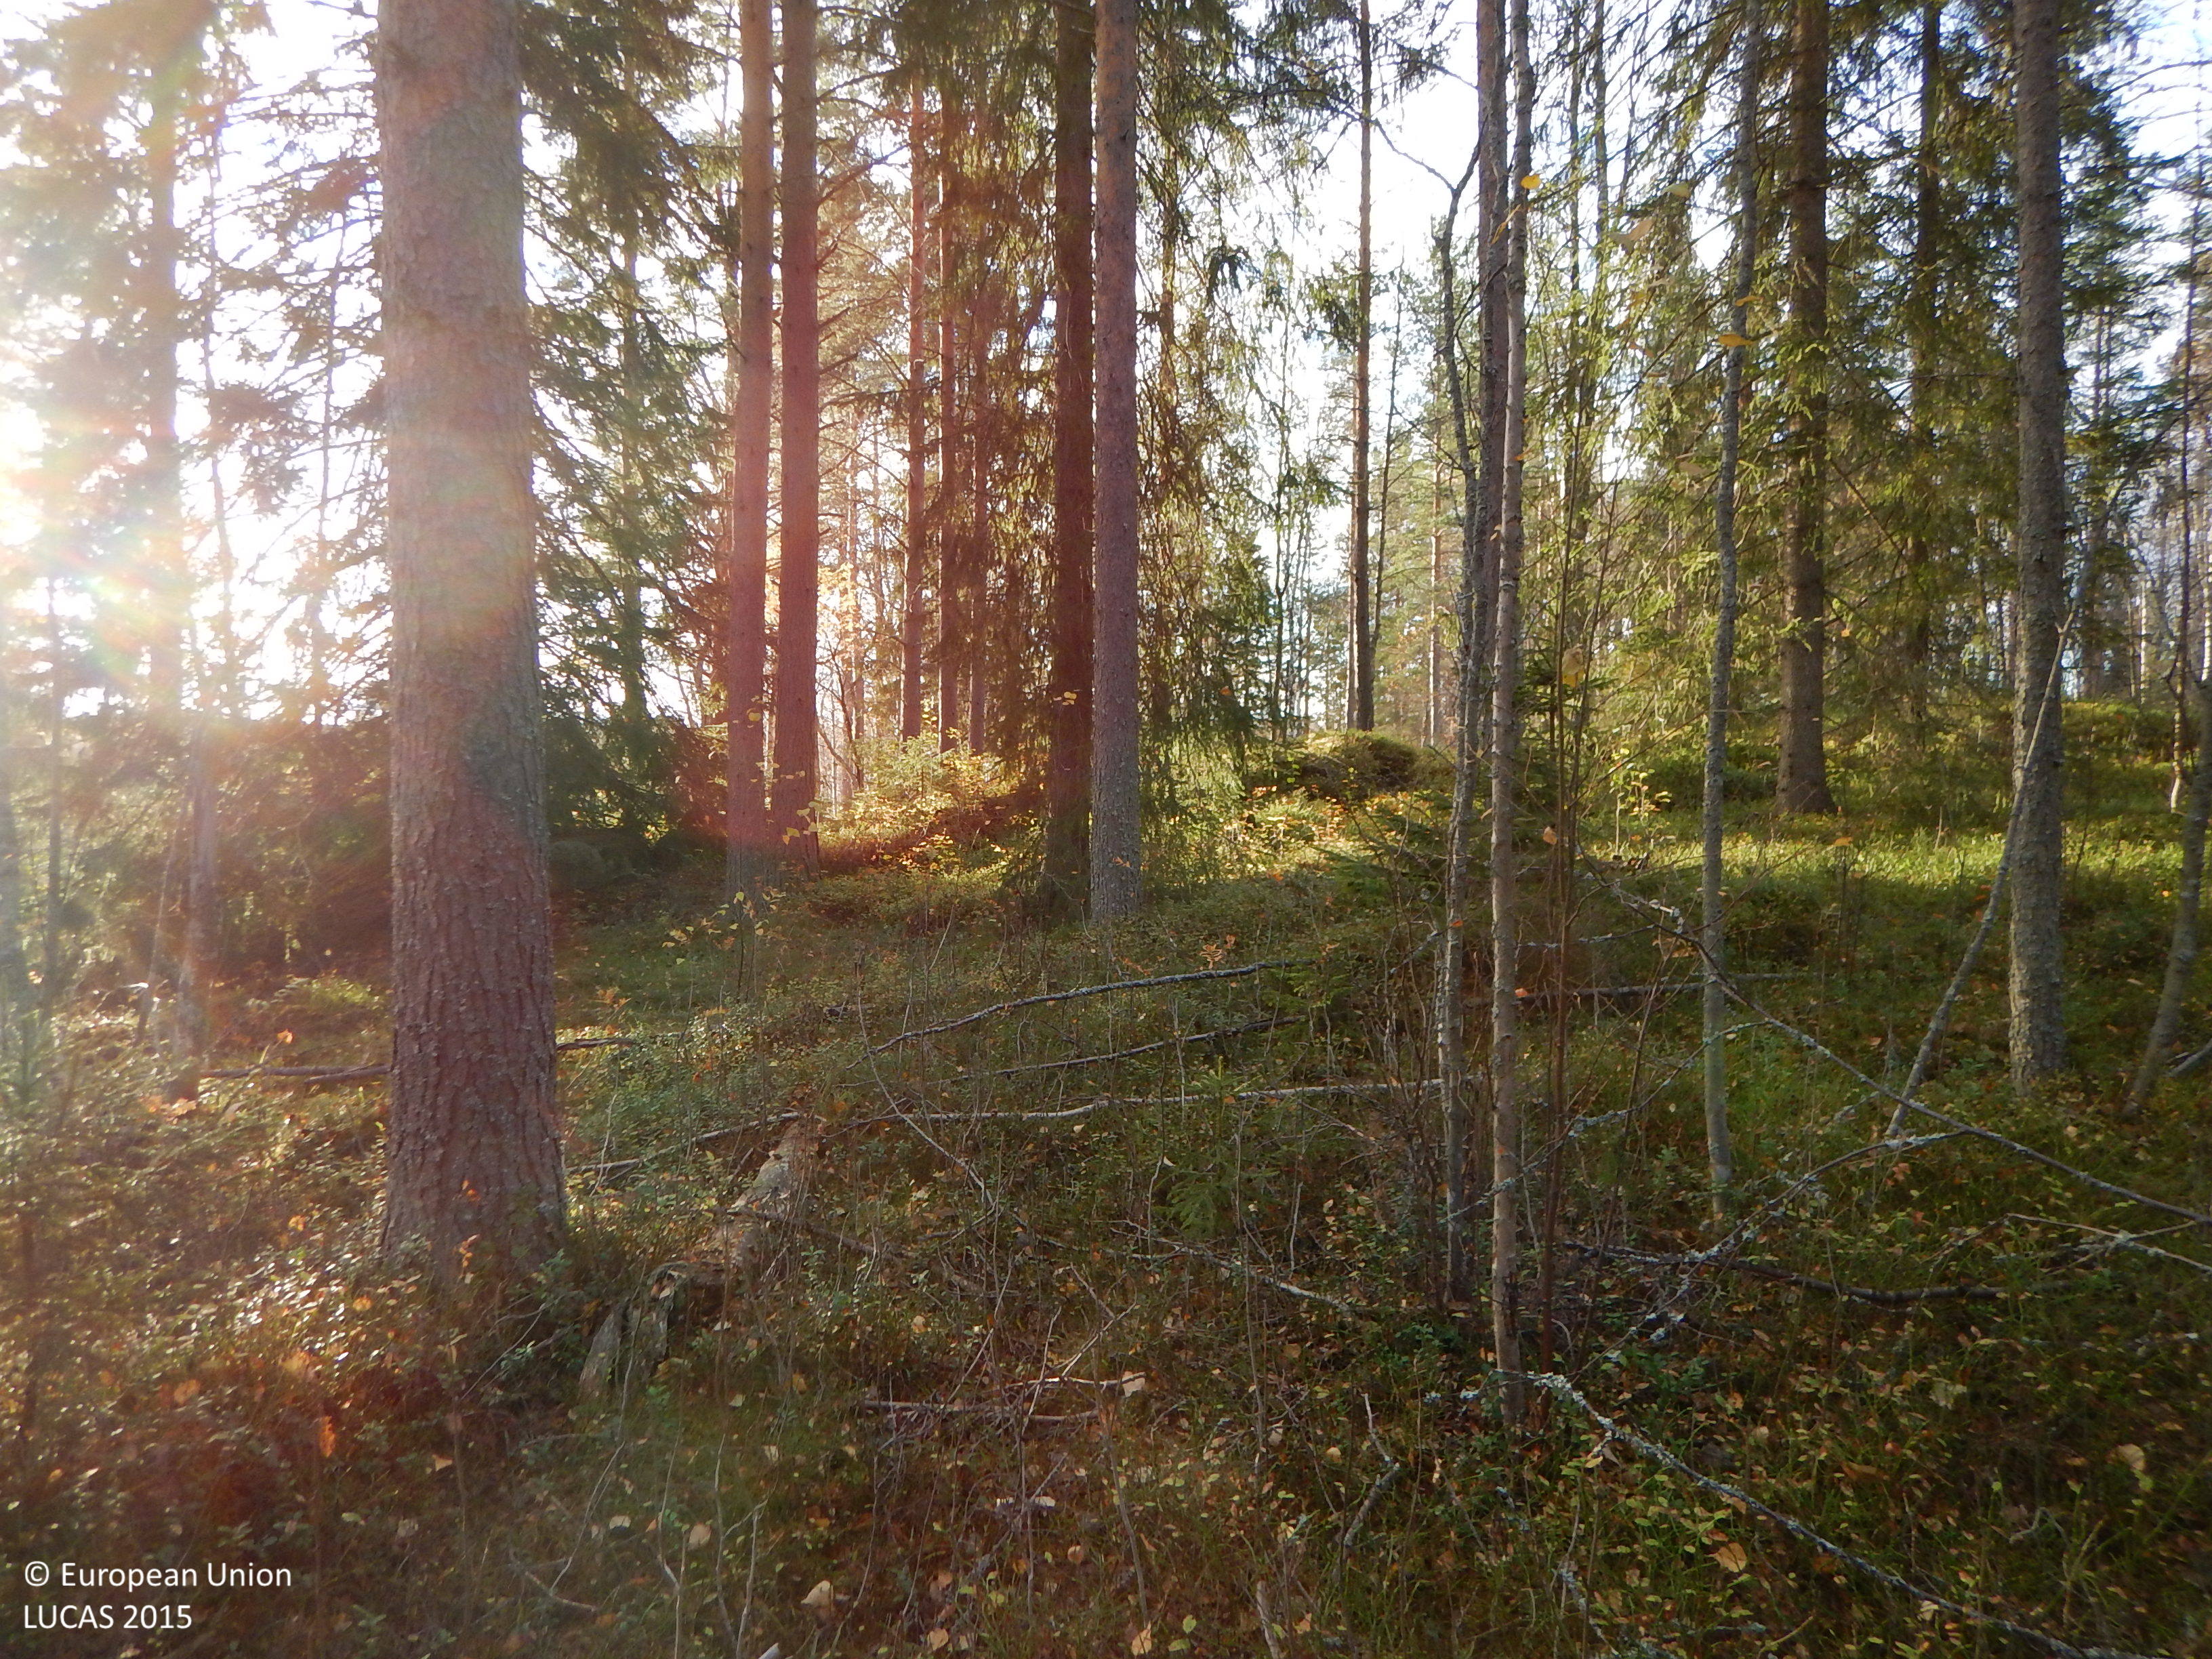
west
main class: Woodland
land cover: Pine dominated coniferous woodland
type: boreal forest
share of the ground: 50 - 75 %
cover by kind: coniferous forest trees 50 %, shrubs 20 %, herbaceous plants 15 %, broadleaved forest trees 10 %, lichens and mosses 5 %
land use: Residential
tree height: > 5 m
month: October
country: SE
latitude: 64.9260
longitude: 21.0373
